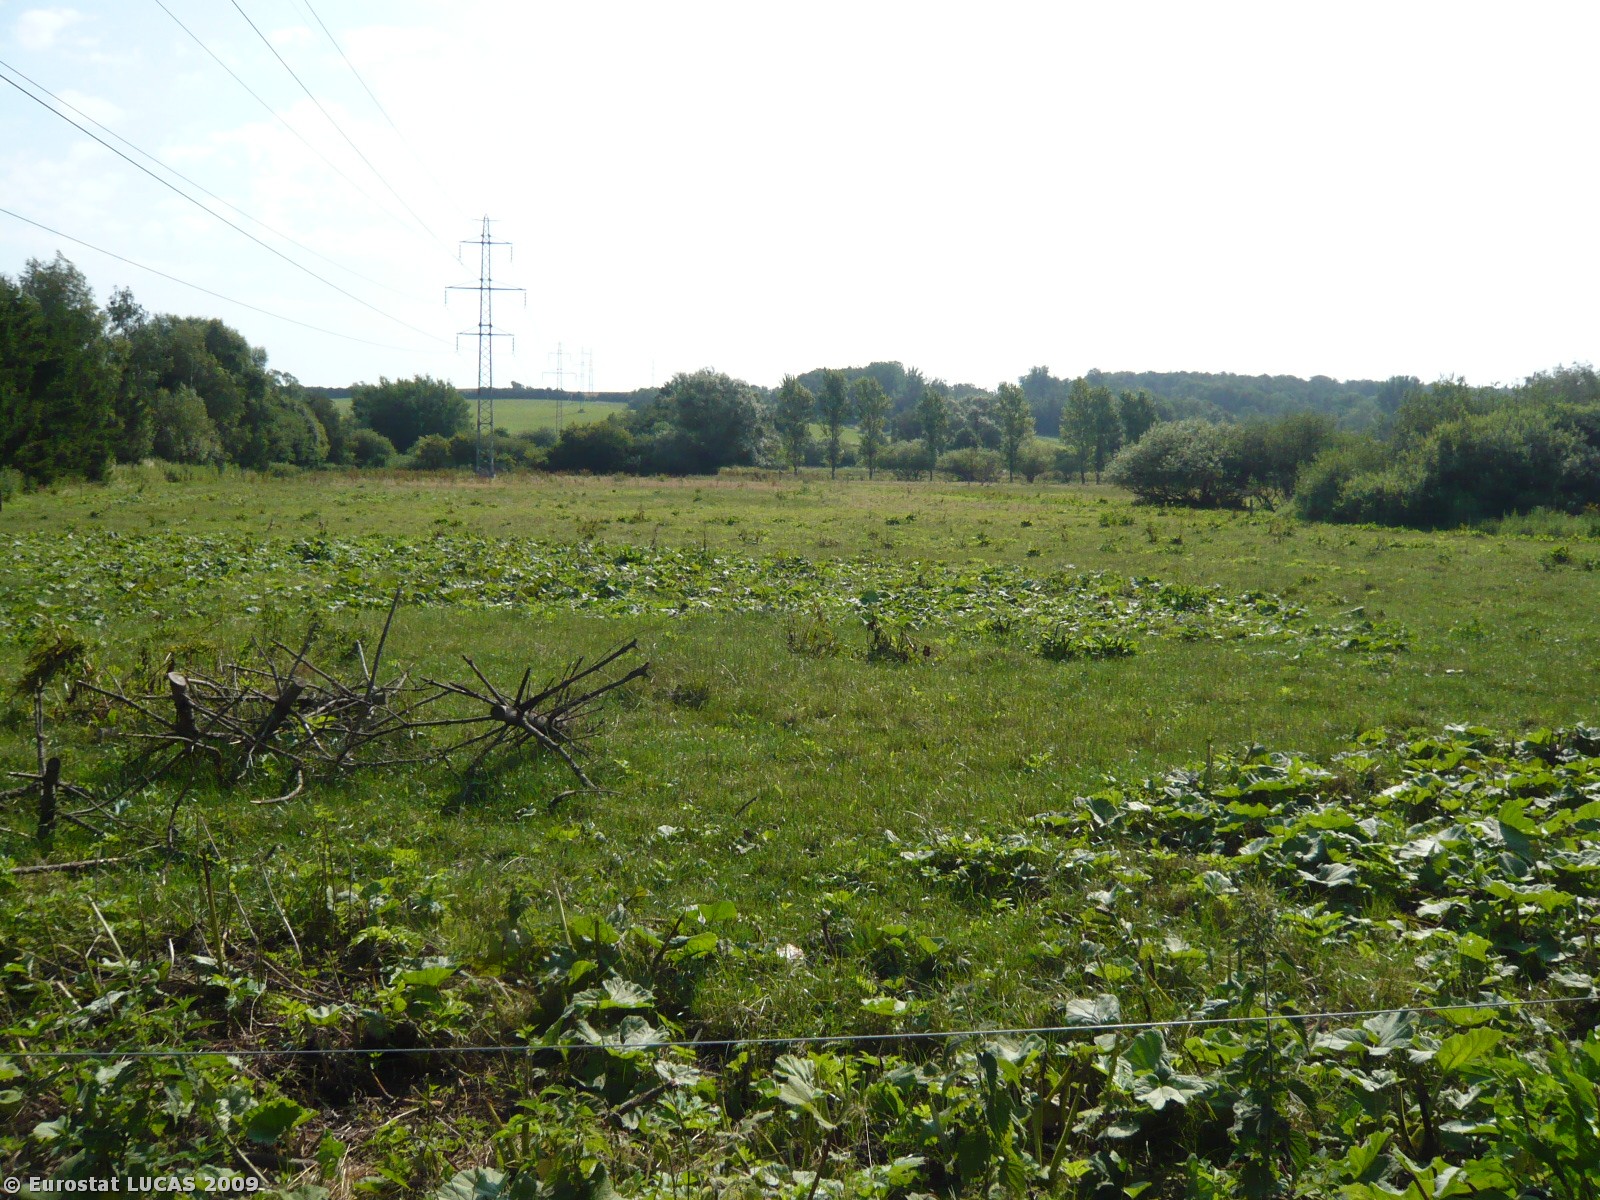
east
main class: Woodland
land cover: Coniferous woodland
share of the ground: > 75 %
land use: Unused
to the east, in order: Coniferous woodland; Tracks; Fences; Grassland without tree/shrub cover; Fences; Broadleaved woodland; Rivers and streams; Broadleaved woodland
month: July
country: DK
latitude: 55.6358
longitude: 11.7935
